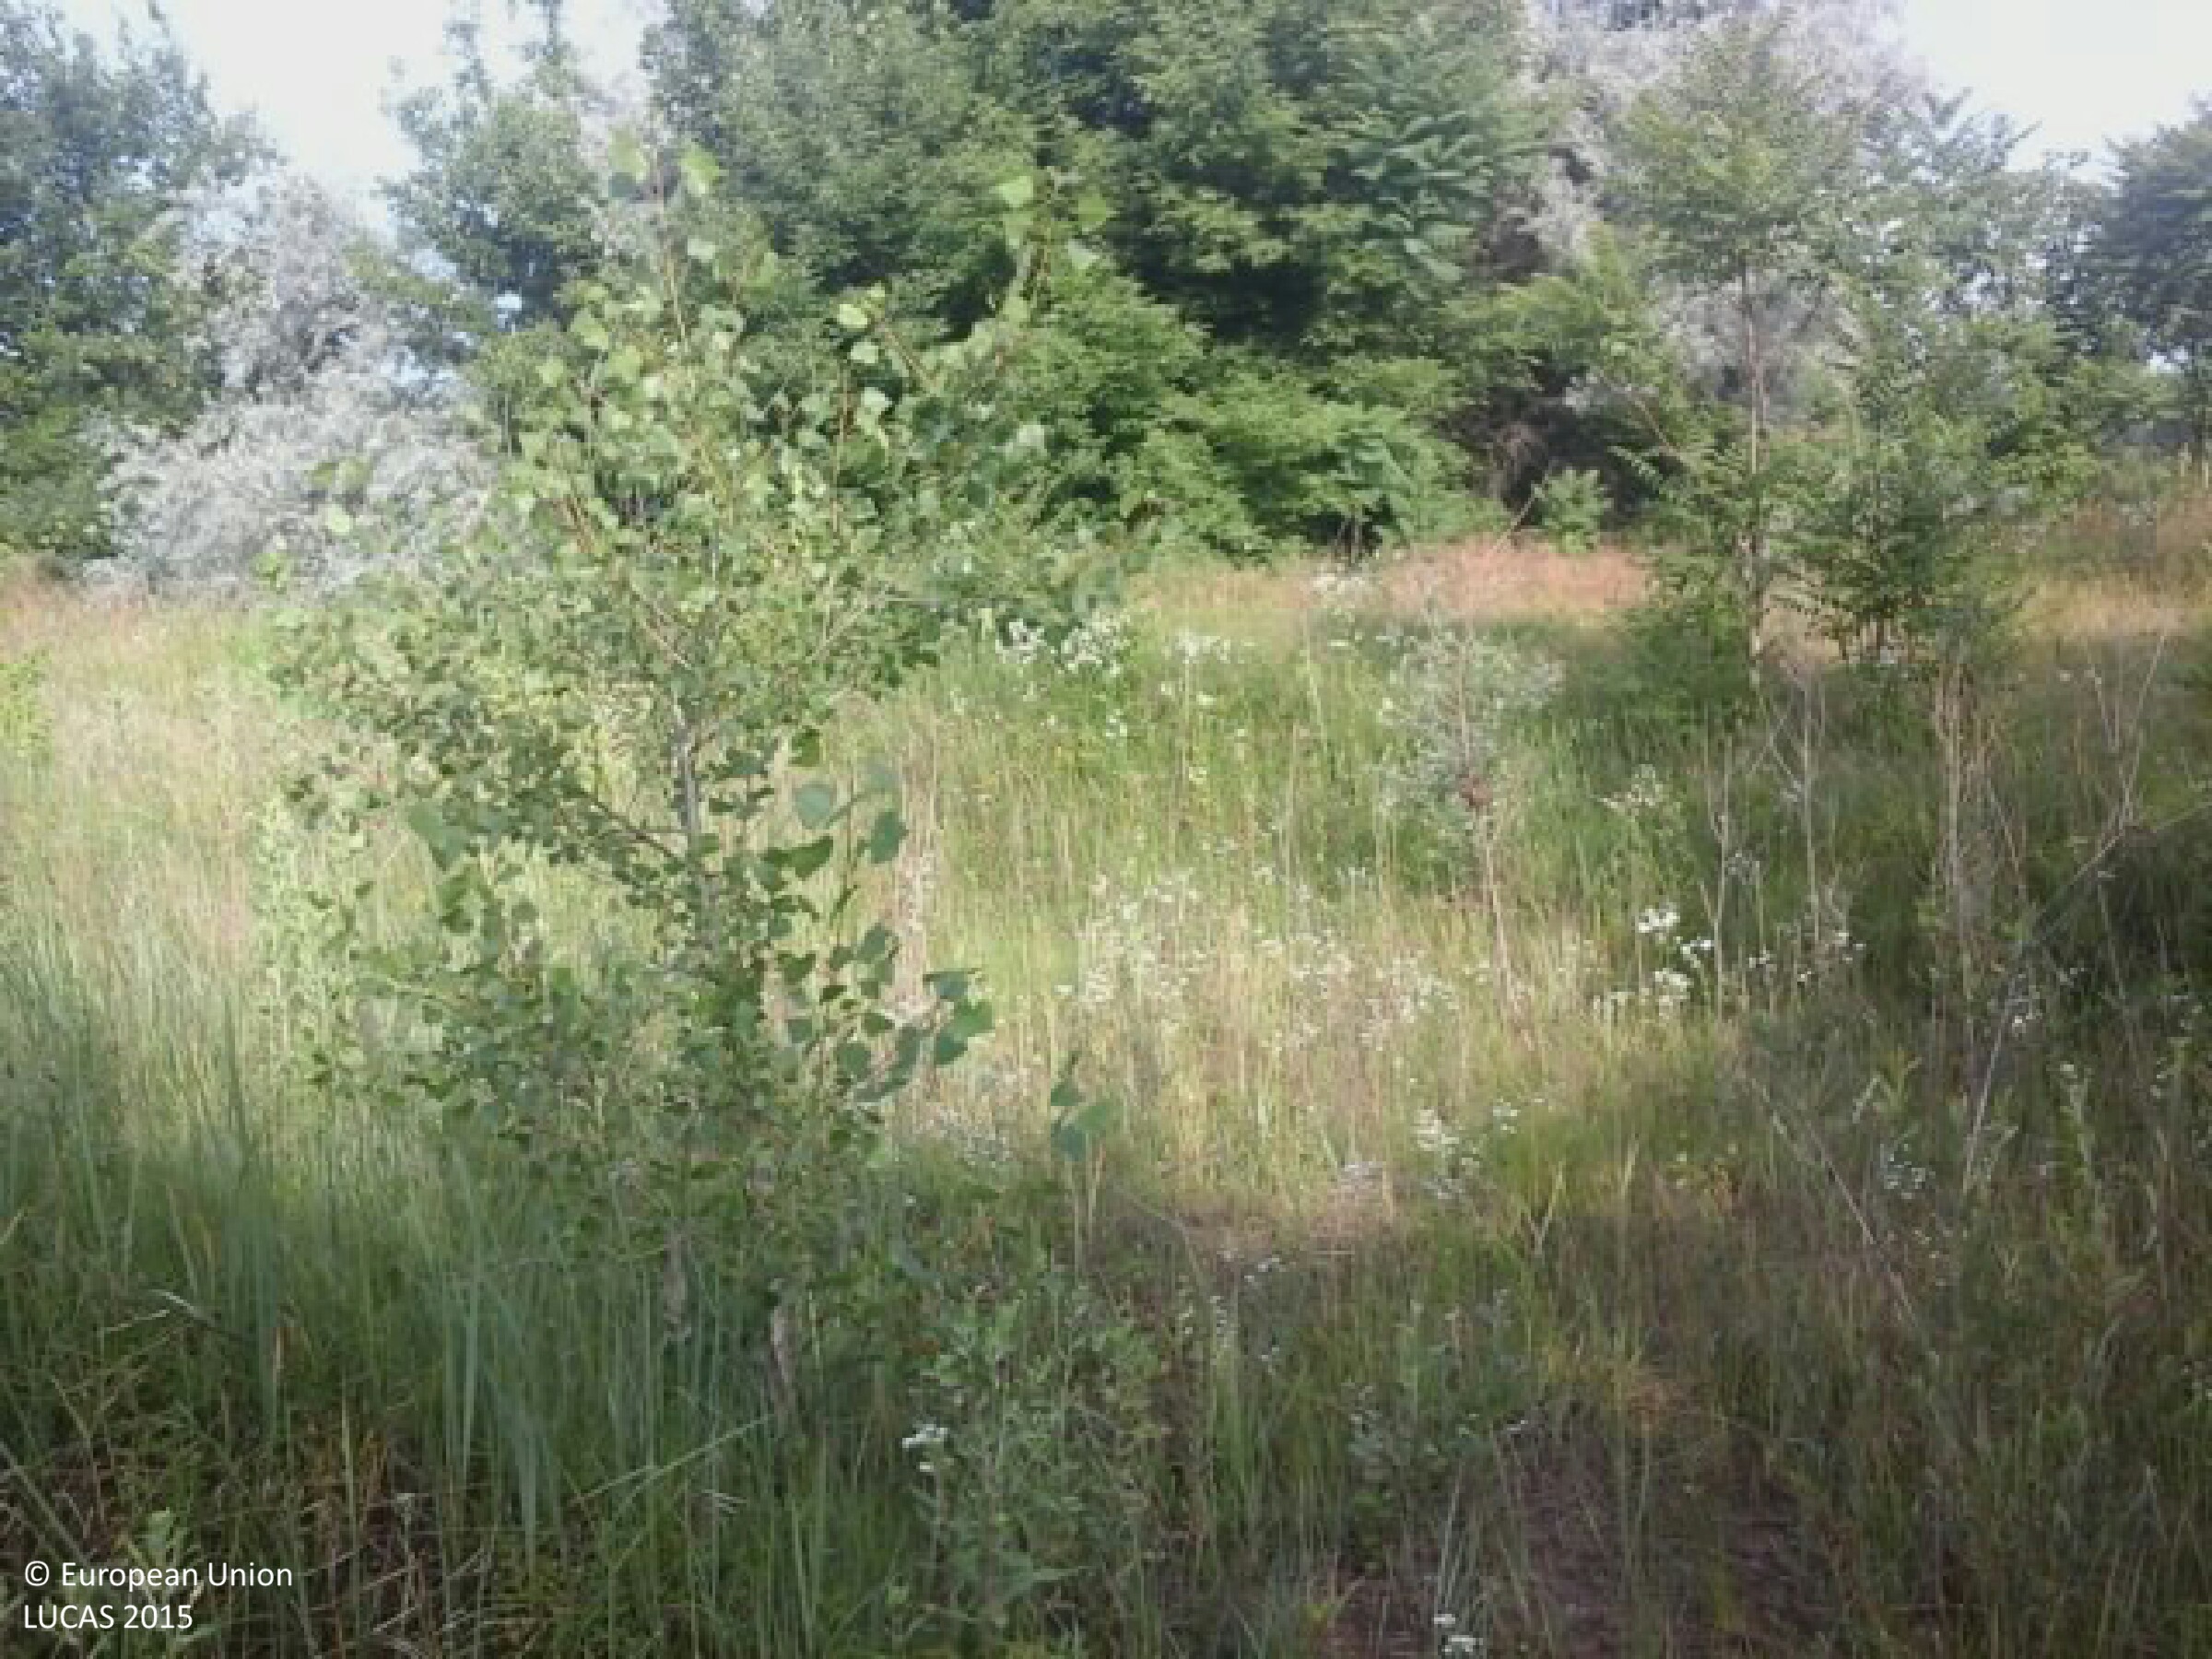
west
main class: Grassland
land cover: Grassland with sparse tree/shrub cover
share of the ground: > 75 %
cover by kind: herbaceous plants 85 %, shrubs 10 %, broadleaved forest trees 5 %
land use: Semi-natural and natural areas not in use
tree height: < 5 m
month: June
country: HU
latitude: 46.1893
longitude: 18.9913
